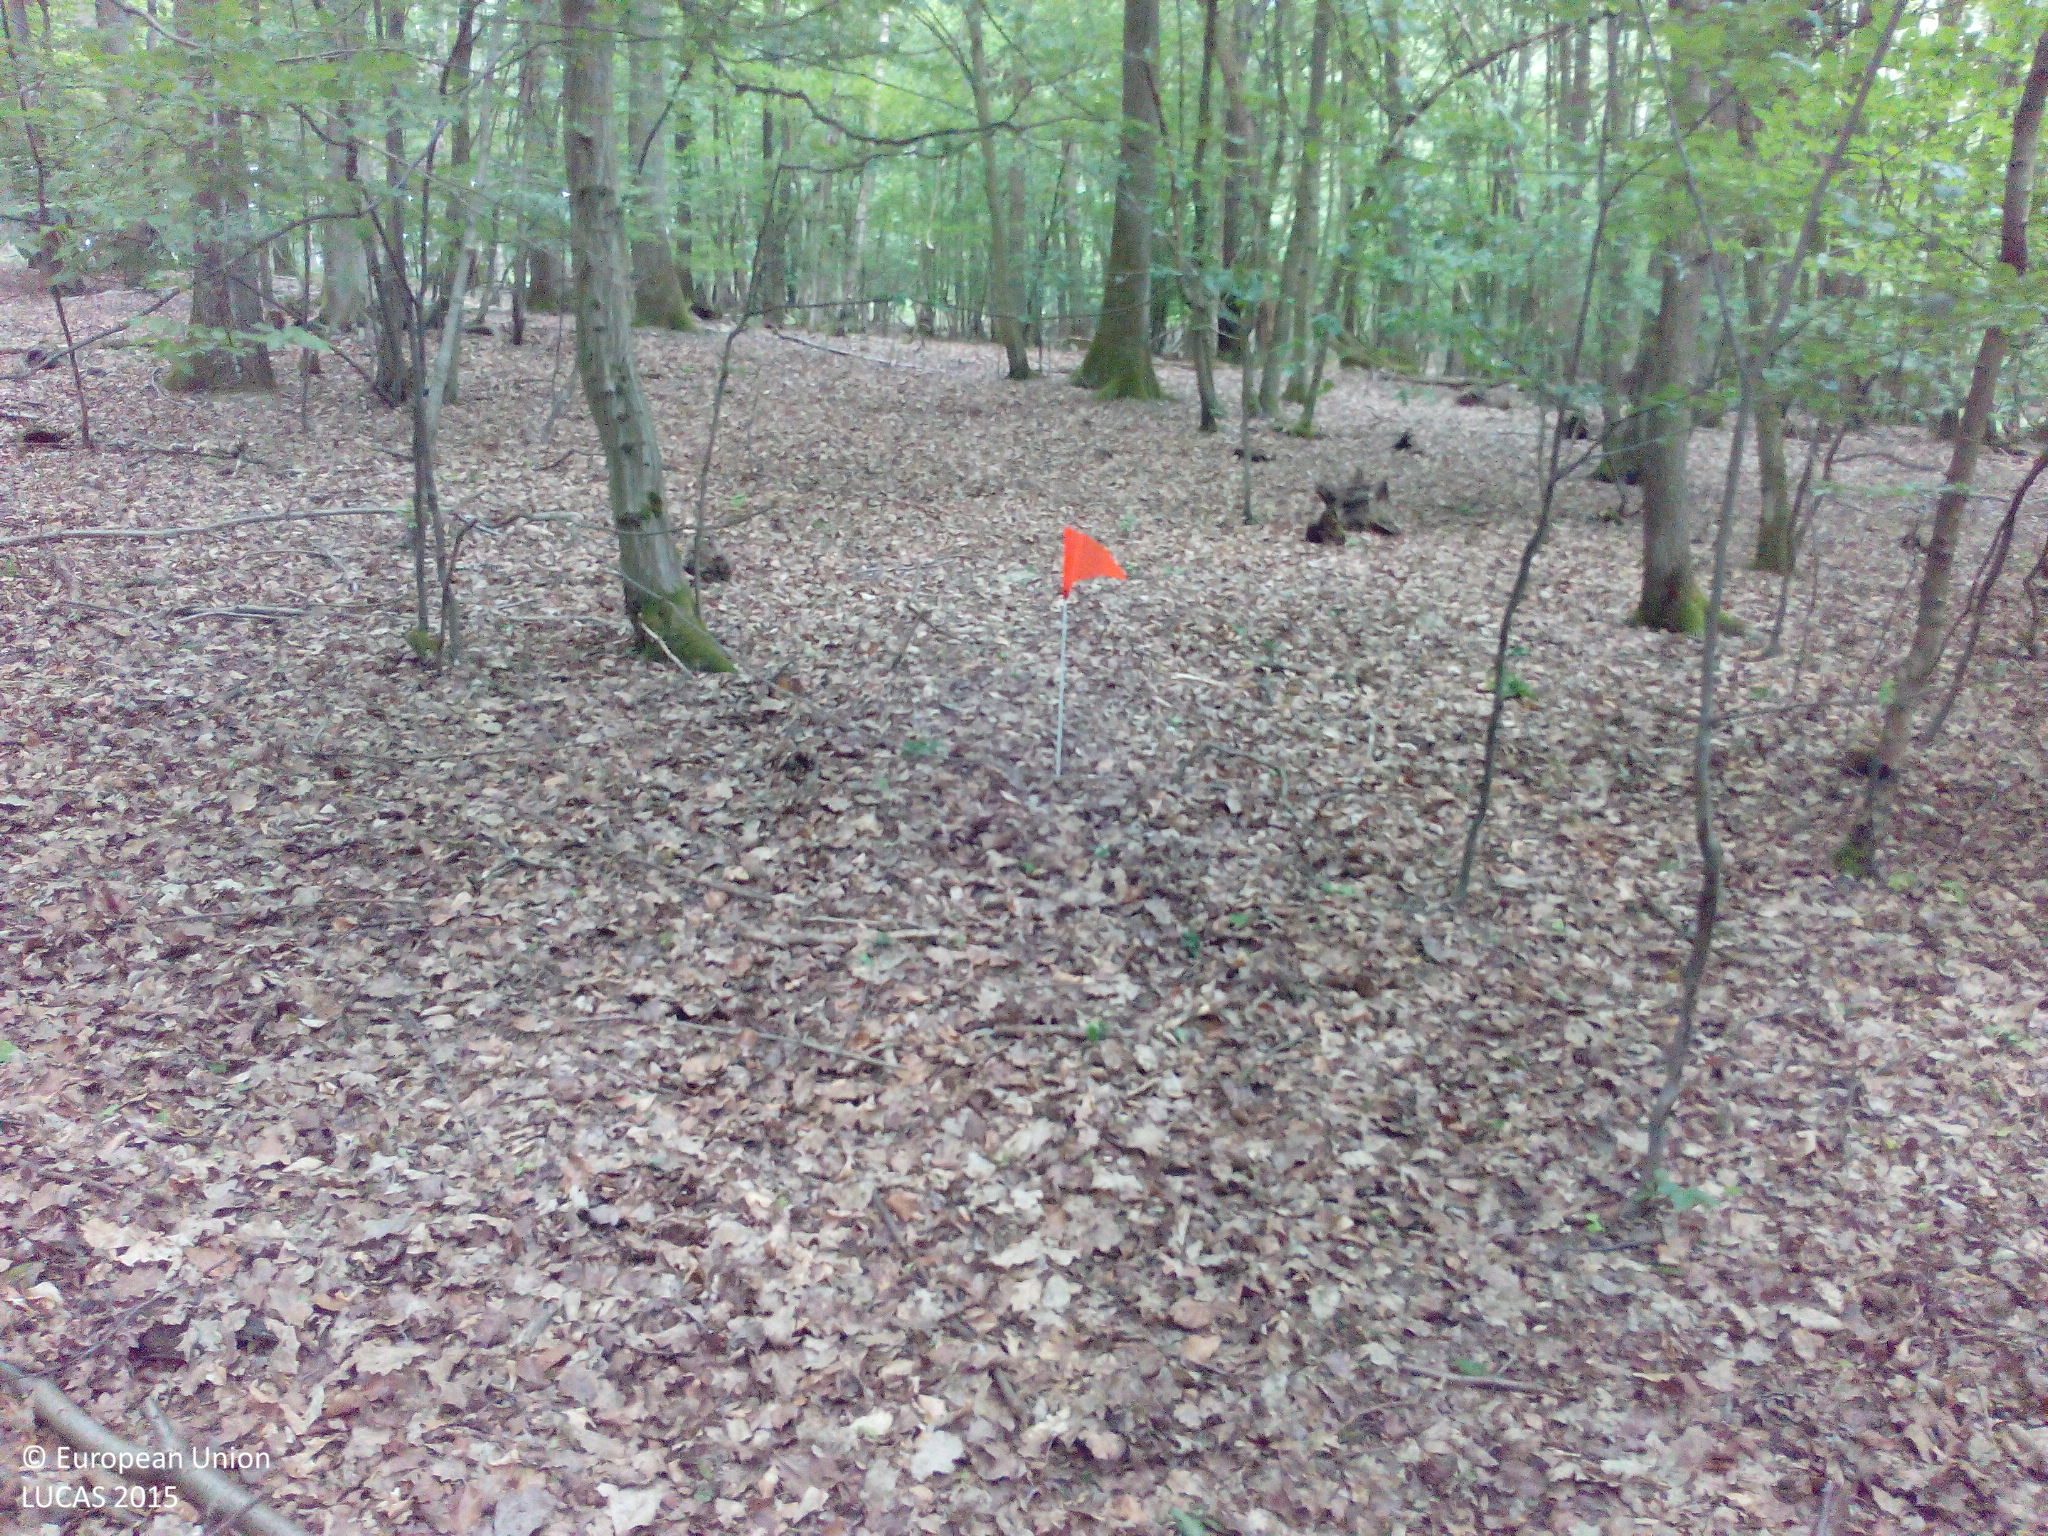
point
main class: Woodland
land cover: Broadleaved woodland
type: mesophytic deciduous forest
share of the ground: > 75 %
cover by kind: broadleaved forest trees 90 %, unconsolidated bare surface 10 %
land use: Forestry
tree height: > 5 m
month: June
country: DE
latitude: 50.3376
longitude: 8.6094
